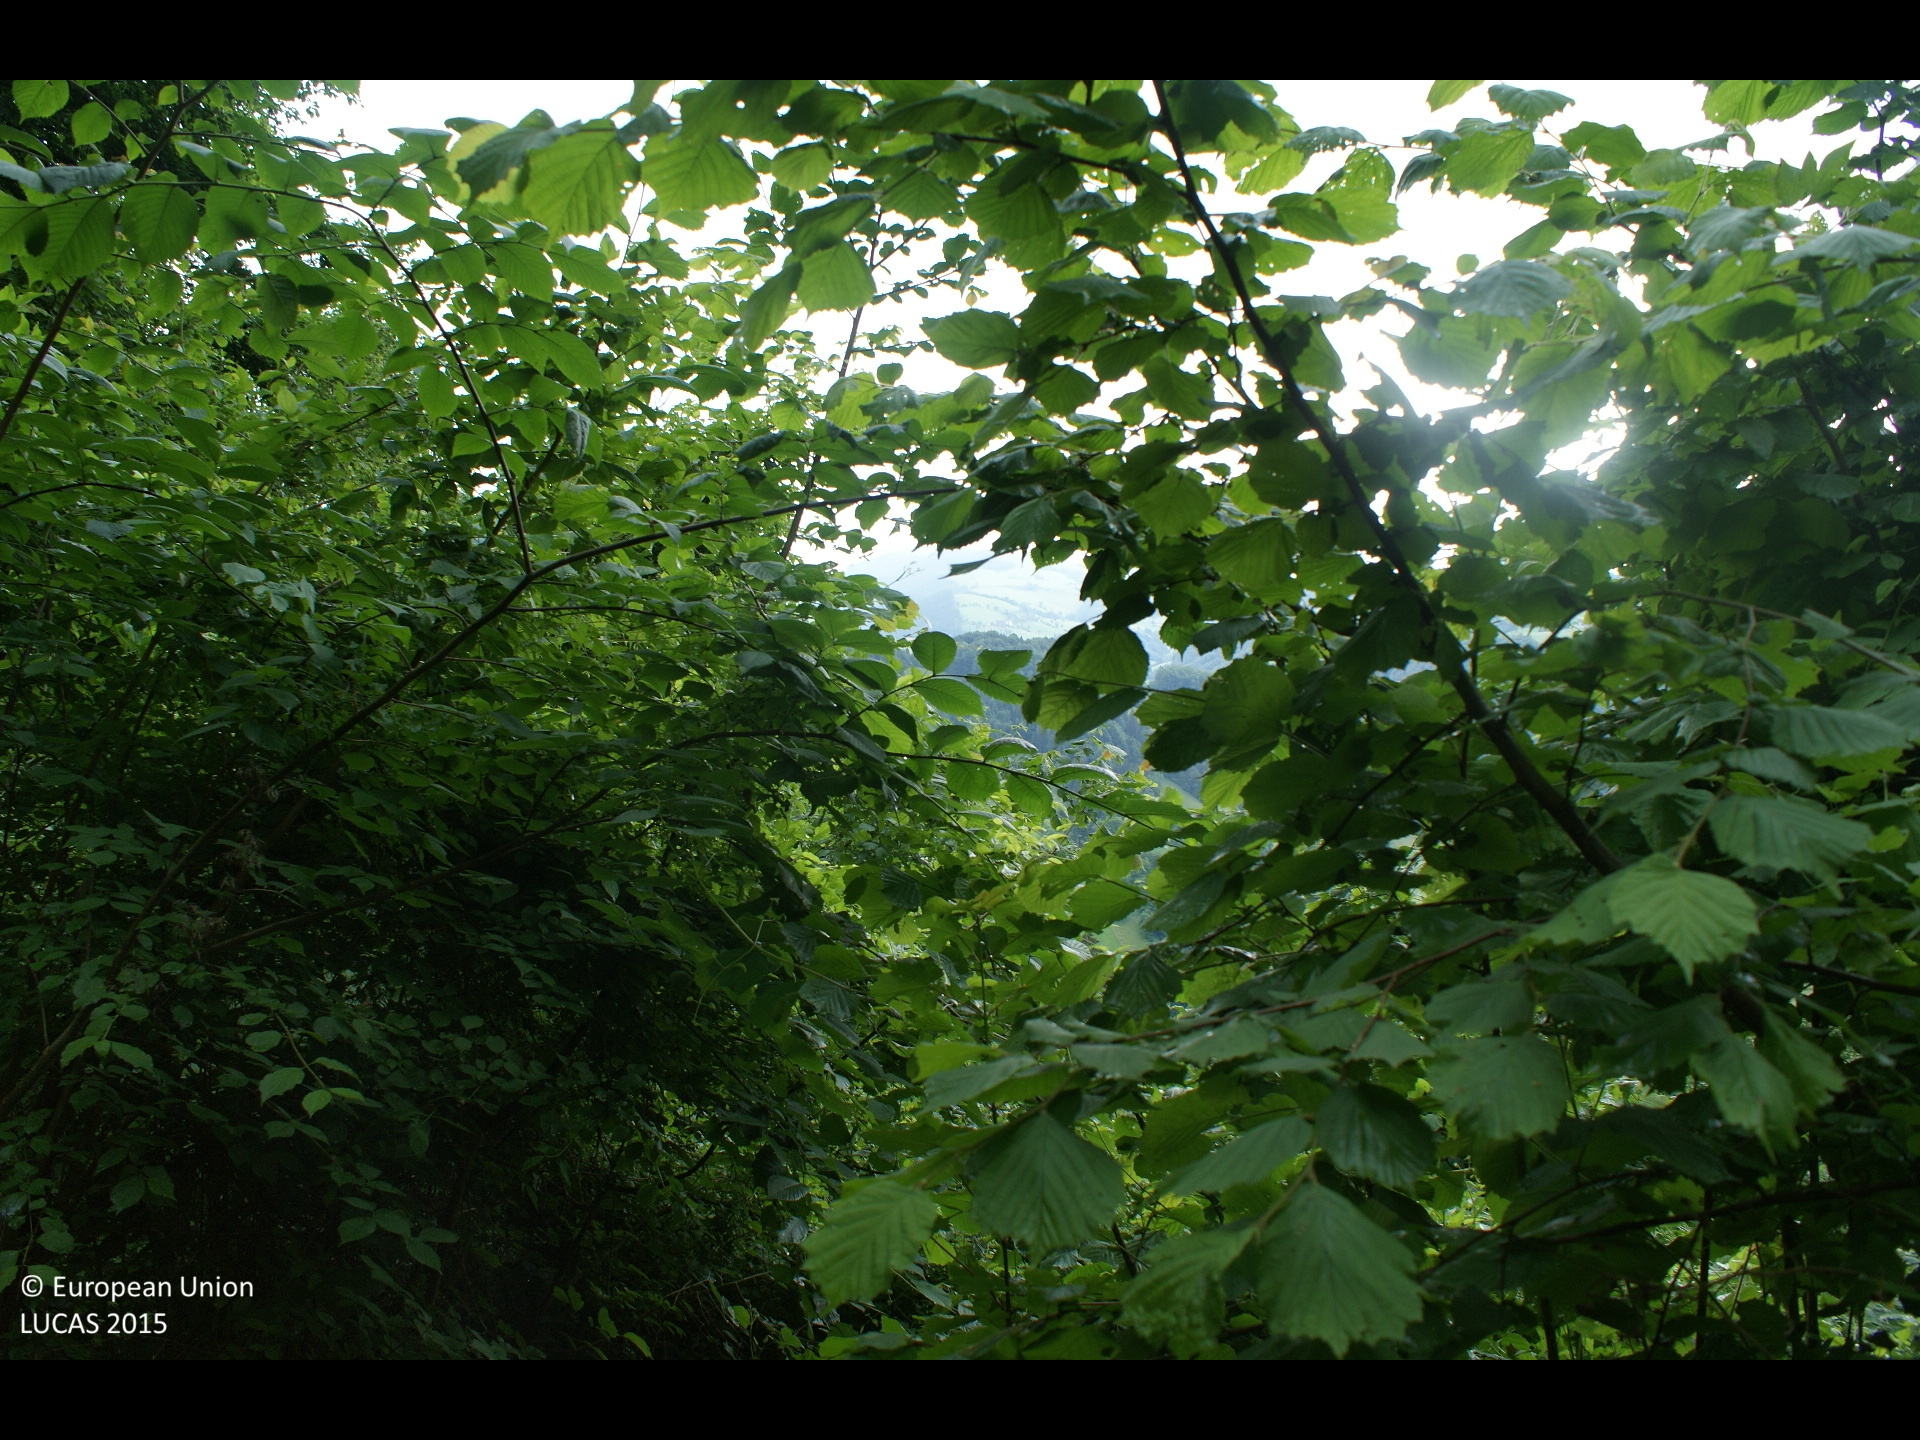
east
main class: Shrubland
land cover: Shrubland with sparse tree cover
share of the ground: > 75 %
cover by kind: shrubs 75 %, herbaceous plants 20 %, broadleaved forest trees 5 %
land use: Forestry
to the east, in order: Shrubland with sparse tree cover; Broadleaved woodland; Fences; Broadleaved woodland; Grassland without tree/shrub cover; Tracks; Broadleaved woodland; Spruce dominated mixed woodland; Broadleaved woodland; Spruce dominated mixed woodland
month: June
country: AT
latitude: 47.9553
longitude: 14.4055
